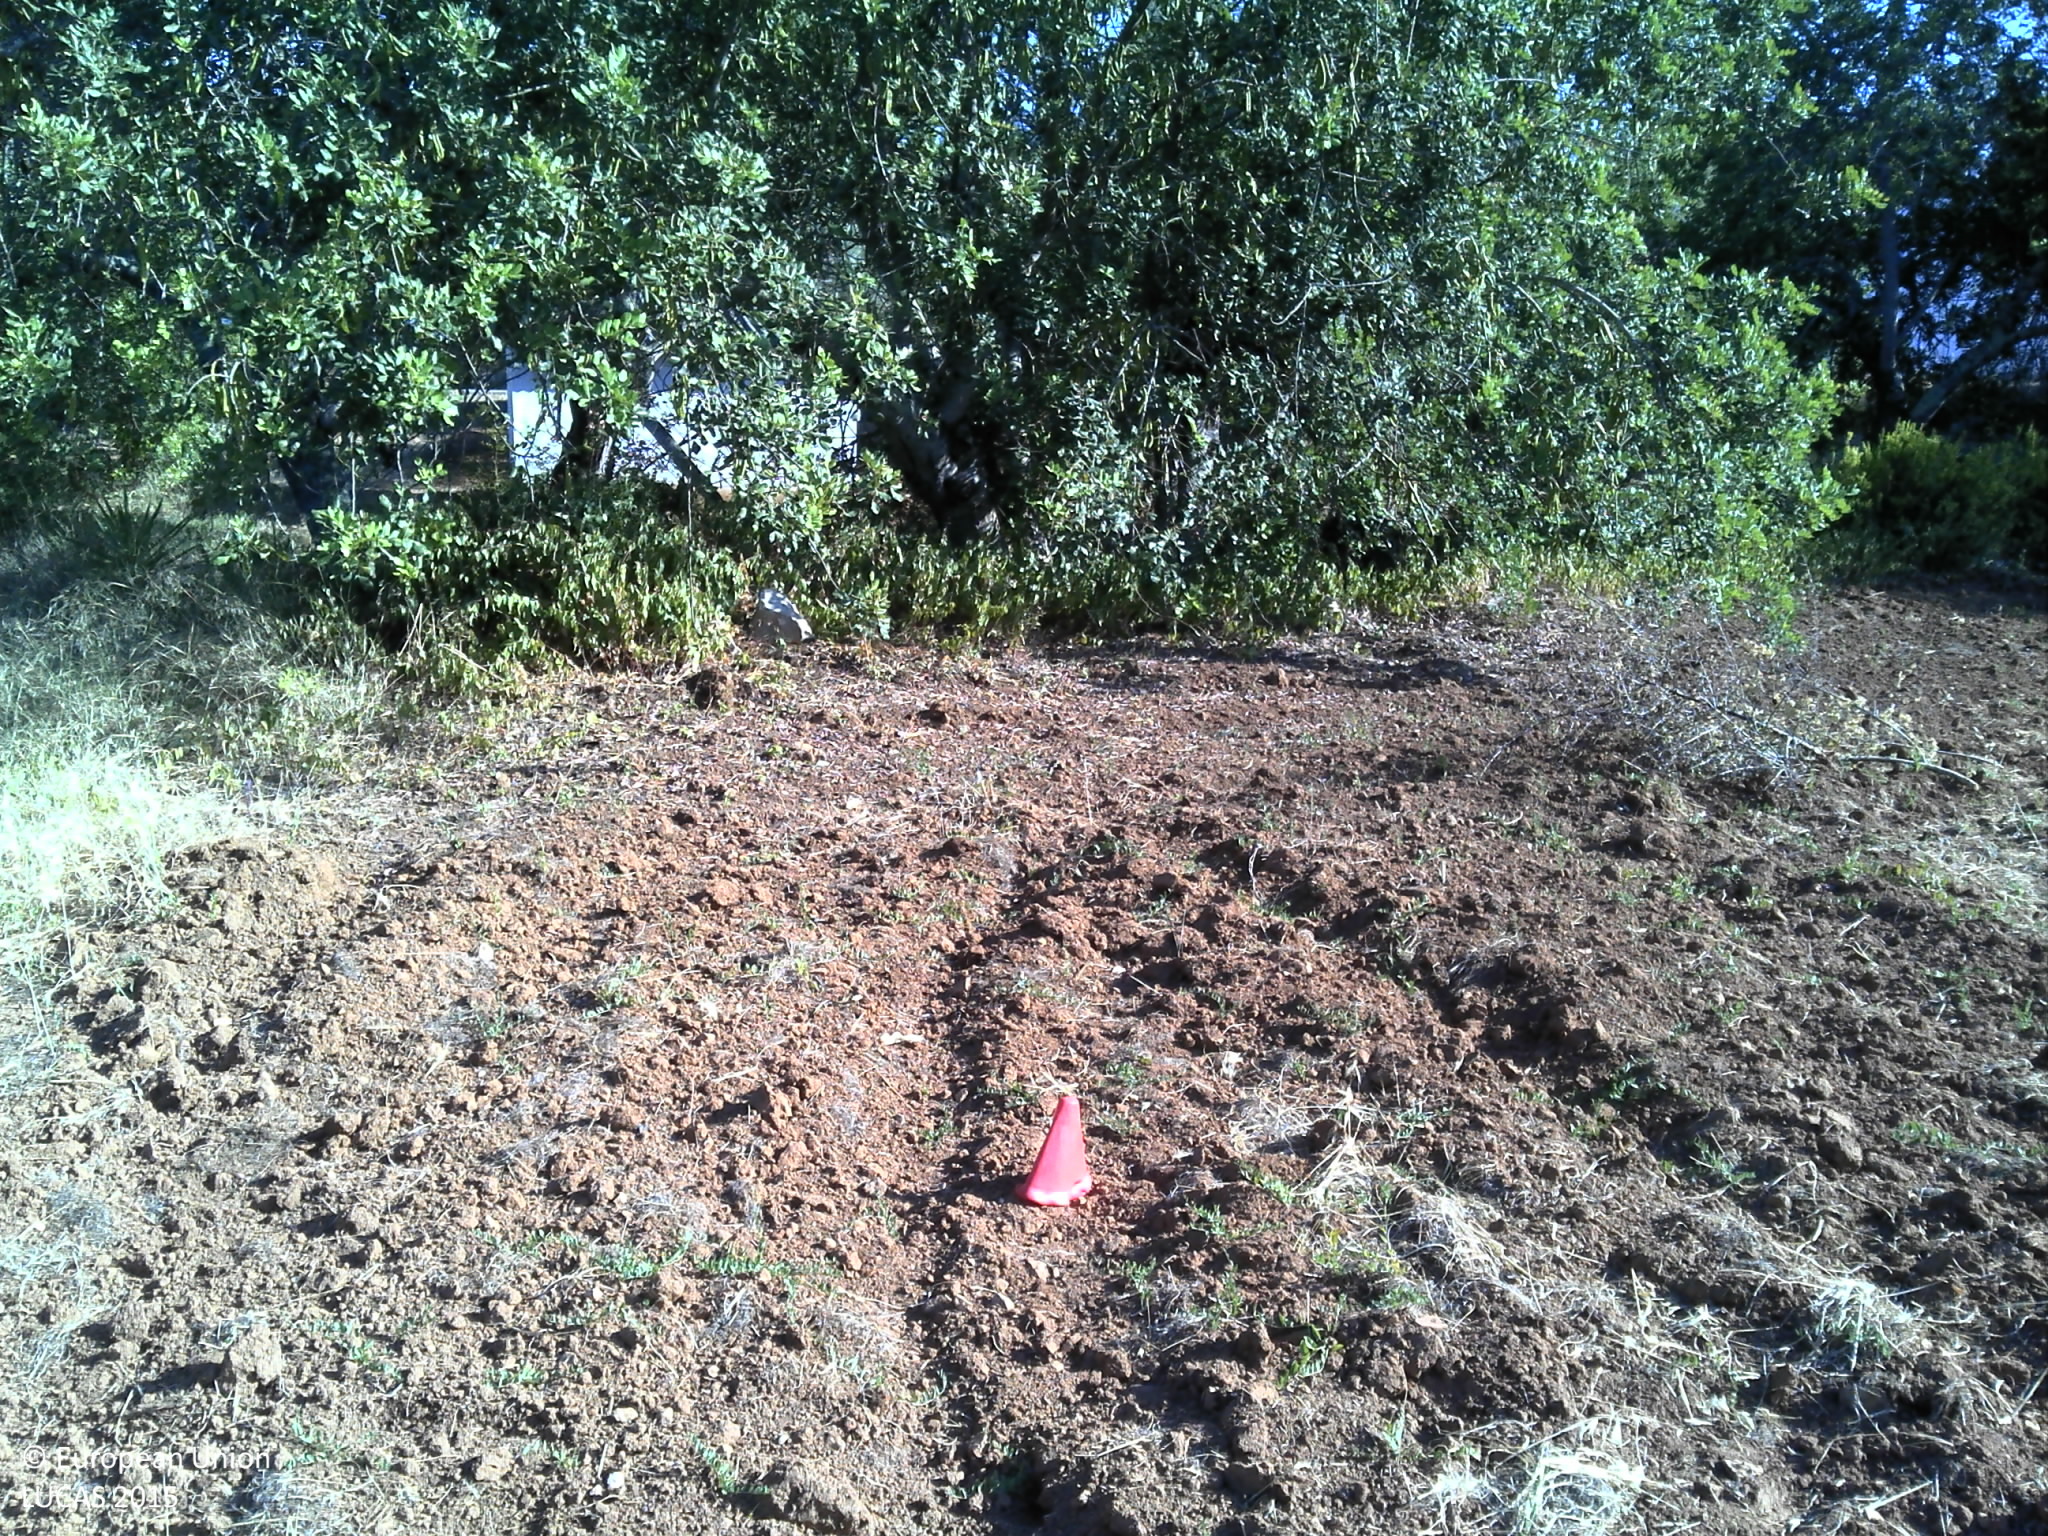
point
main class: Cropland
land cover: Permanent industrial crops
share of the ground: < 10 %
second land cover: Other bare soil
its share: > 75 %
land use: Agriculture (excluding fallow land and kitchen gardens)
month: June
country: PT
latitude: 37.0996
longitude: -7.7503
